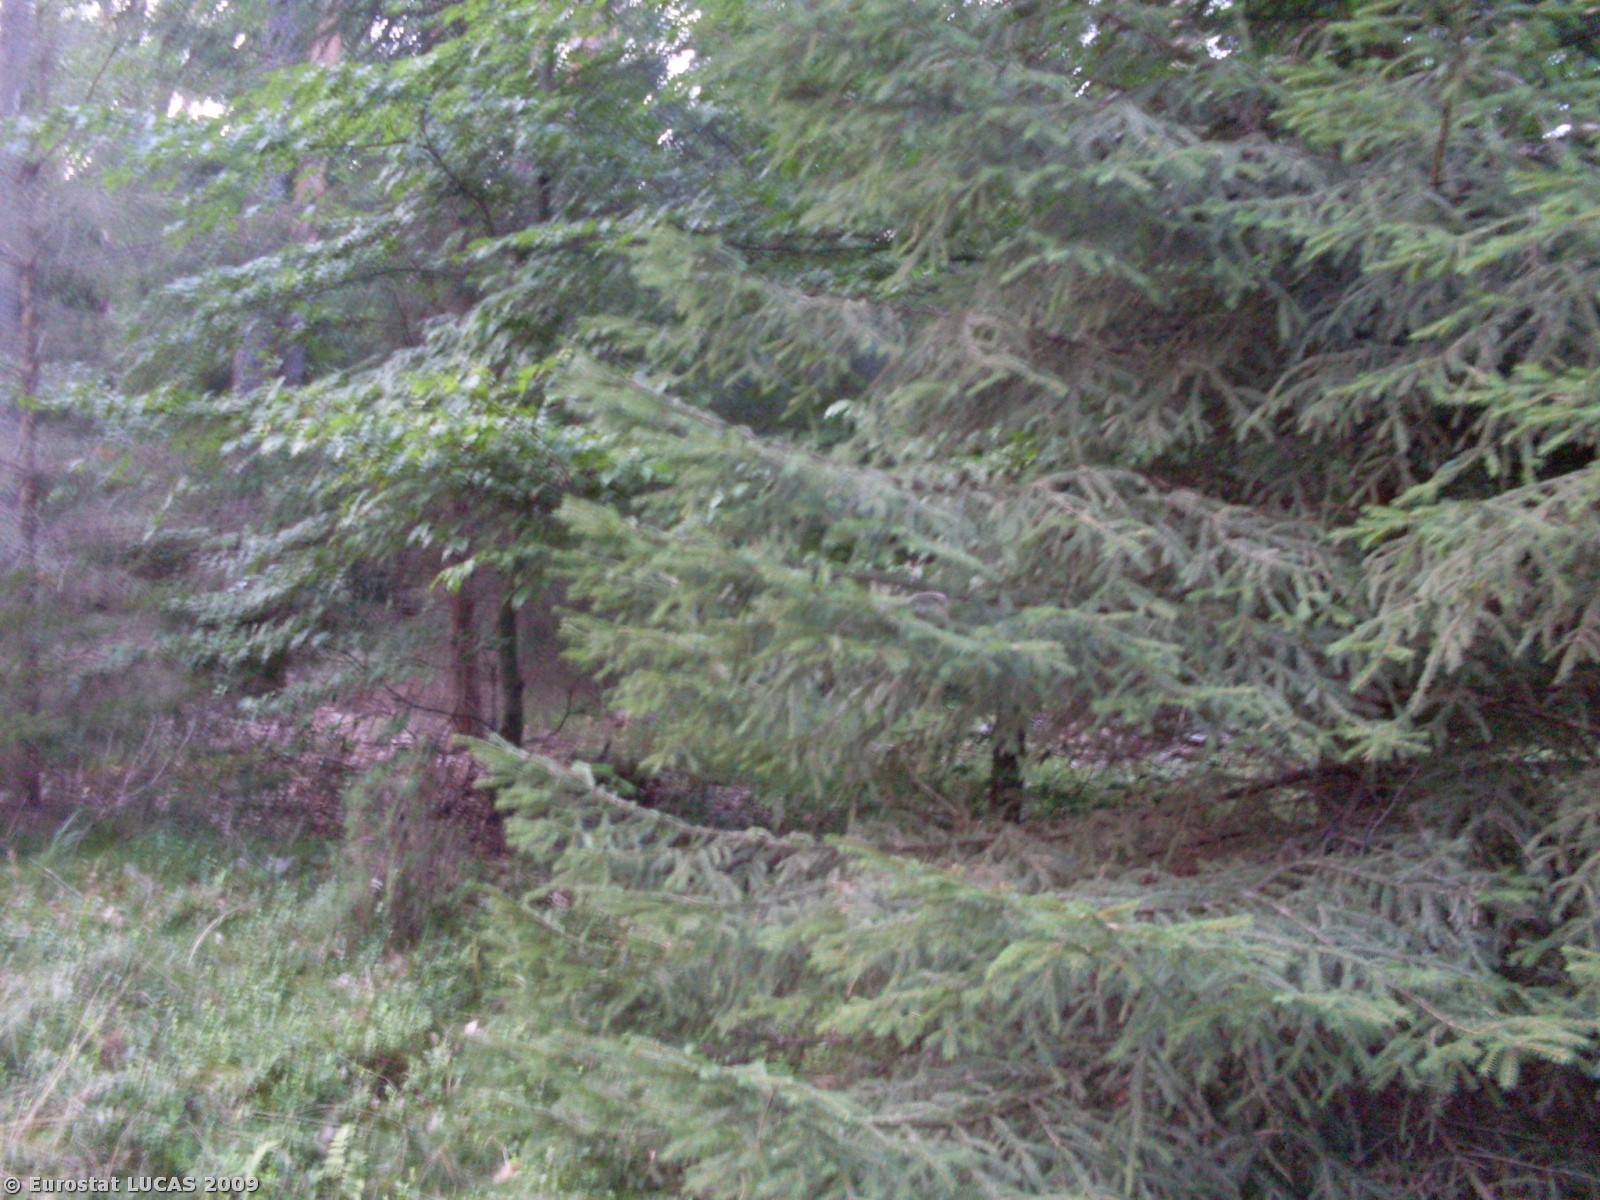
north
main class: Woodland
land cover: Mixed woodland
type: hemiboreal forest and nemoral coniferous forest and mixed broadleaved-coniferous forest
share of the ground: > 75 %
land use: Forestry
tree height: > 5 m
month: July
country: PL
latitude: 53.0048
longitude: 15.9212
